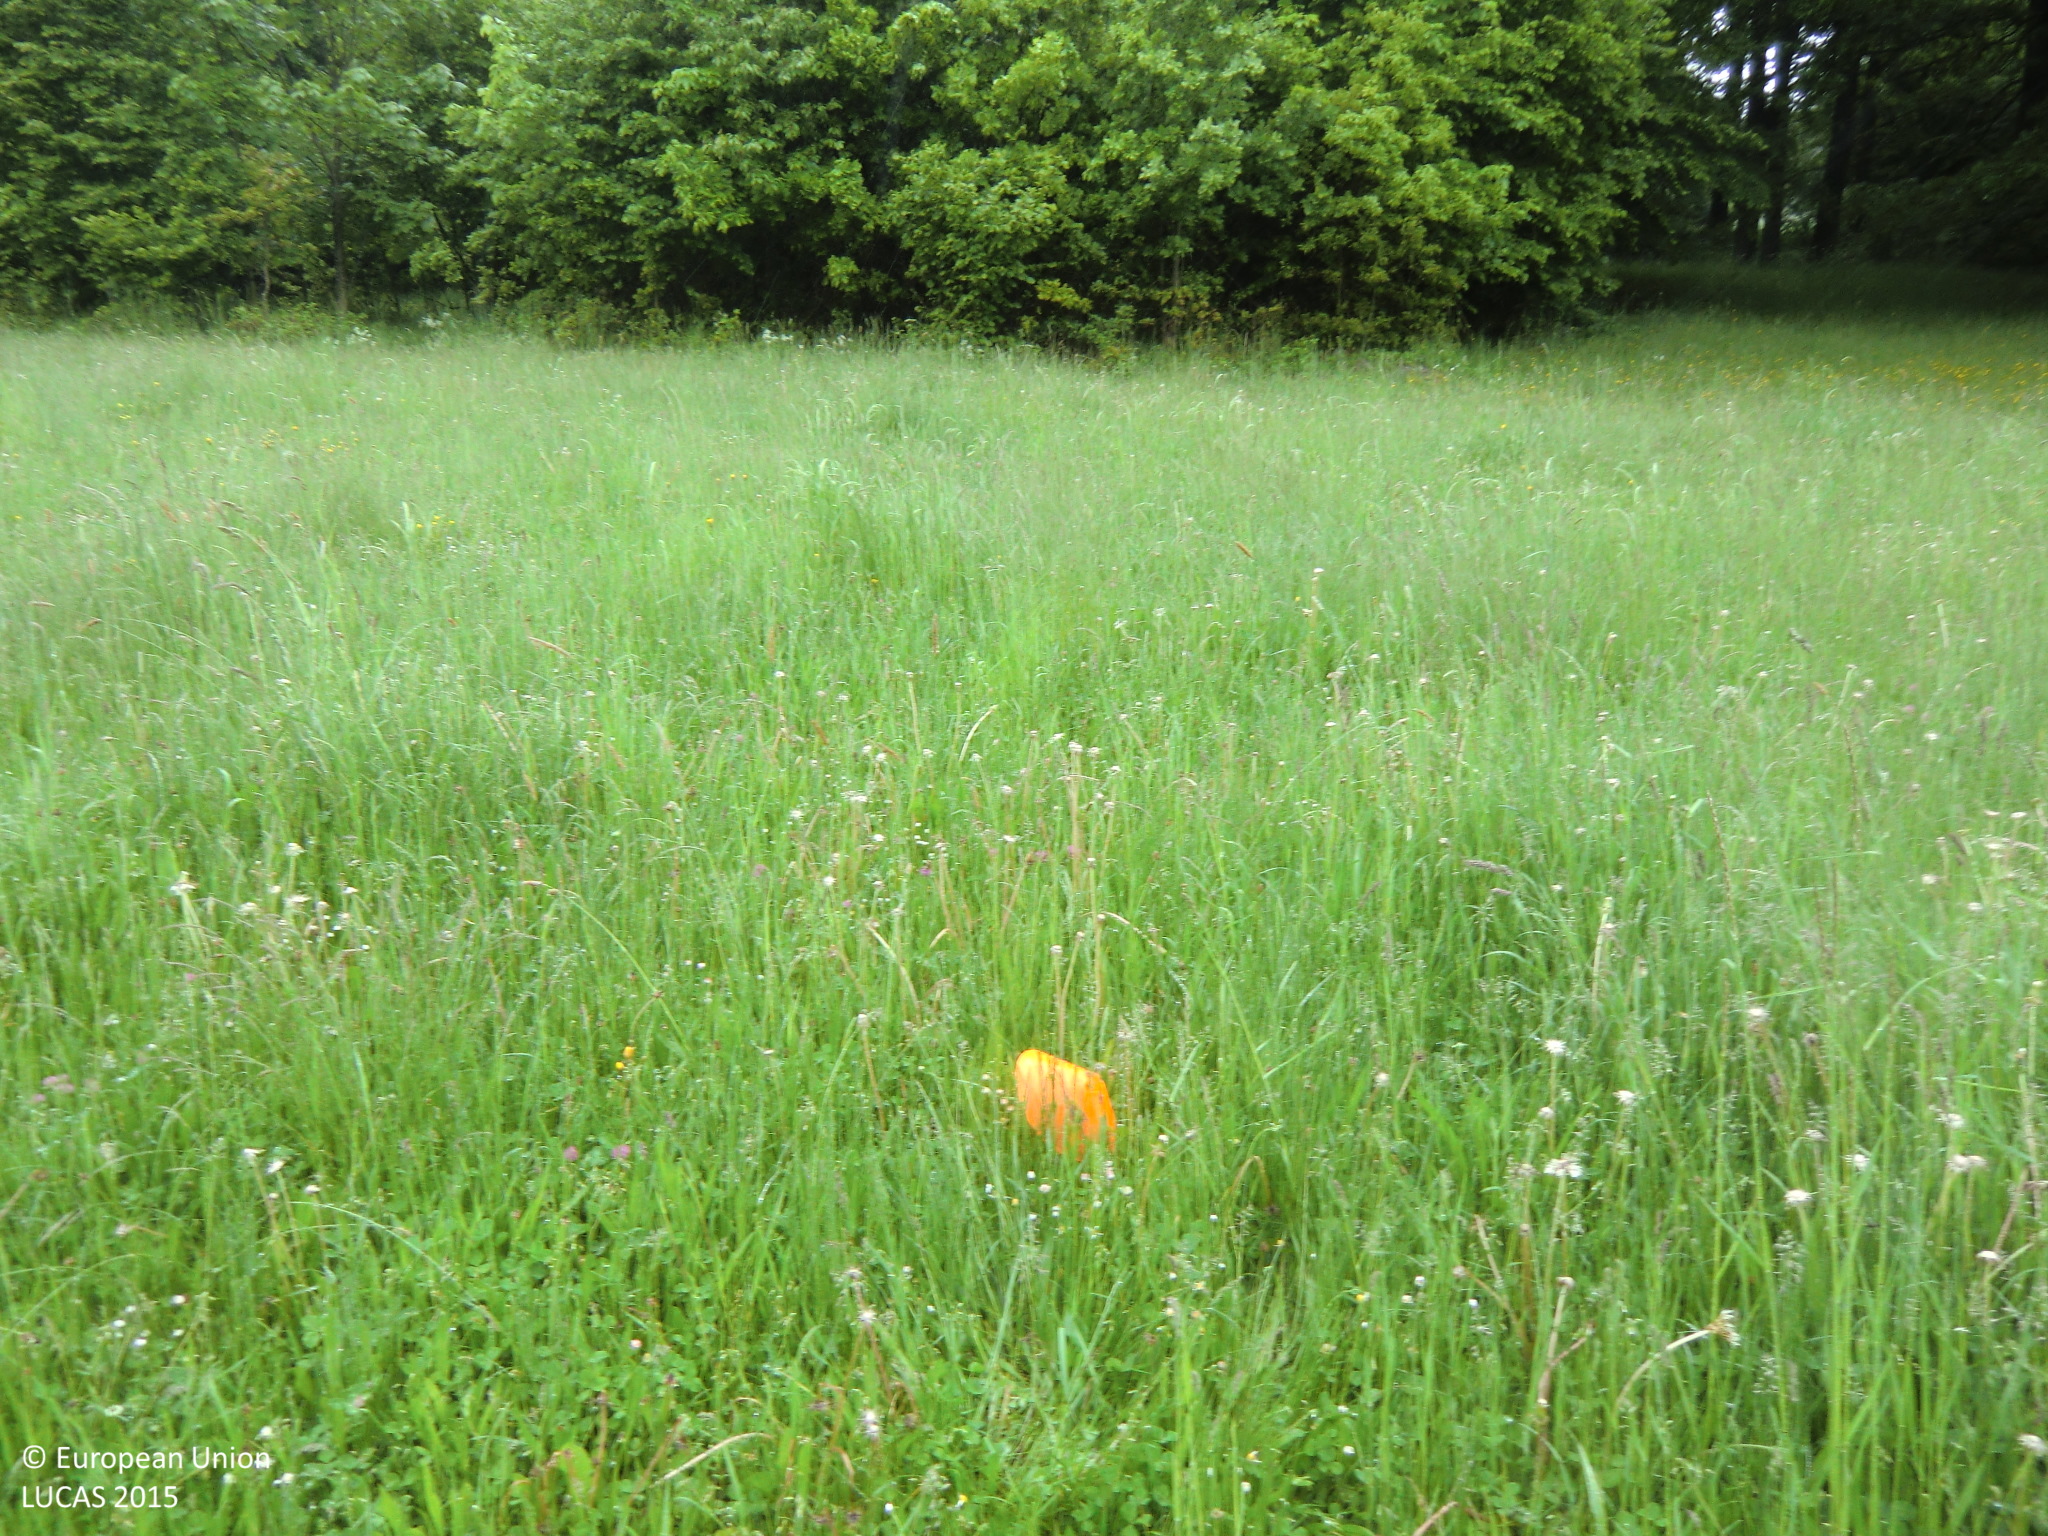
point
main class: Grassland
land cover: Grassland without tree/shrub cover
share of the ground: > 75 %
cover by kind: herbaceous plants 100 %
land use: Agriculture (excluding fallow land and kitchen gardens)
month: May
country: AT
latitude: 48.4233
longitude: 14.4193
